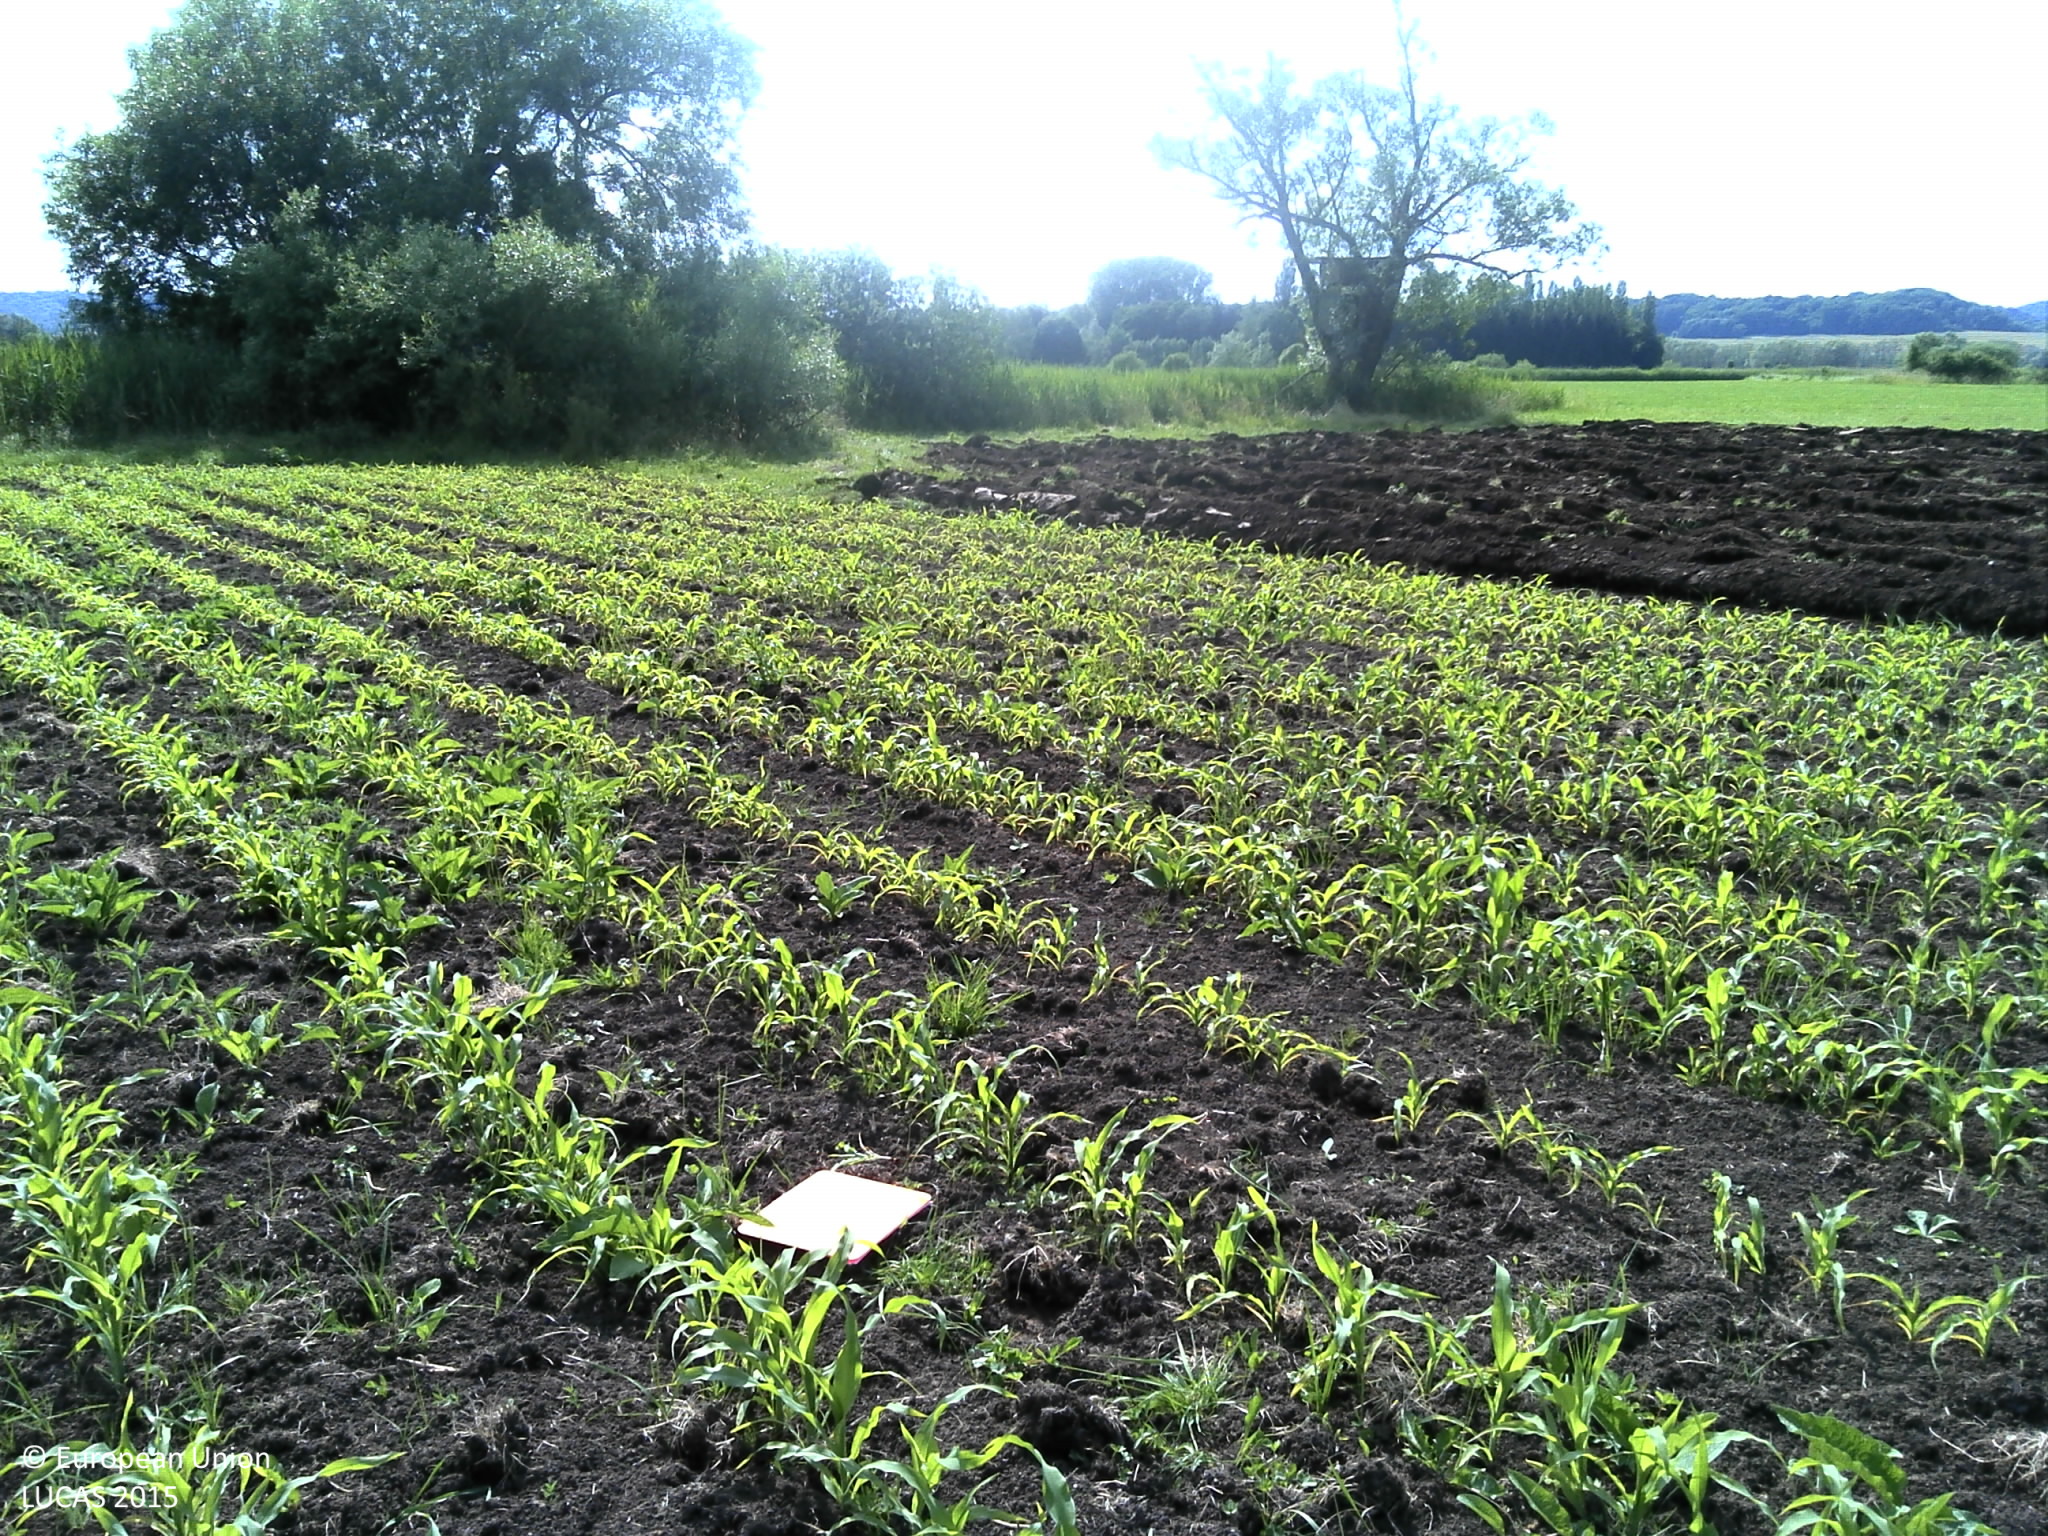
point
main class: Cropland
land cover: Maize
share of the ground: 10 - 25 %
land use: Agriculture (excluding fallow land and kitchen gardens)
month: June
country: FR
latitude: 49.1936
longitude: 6.4733
